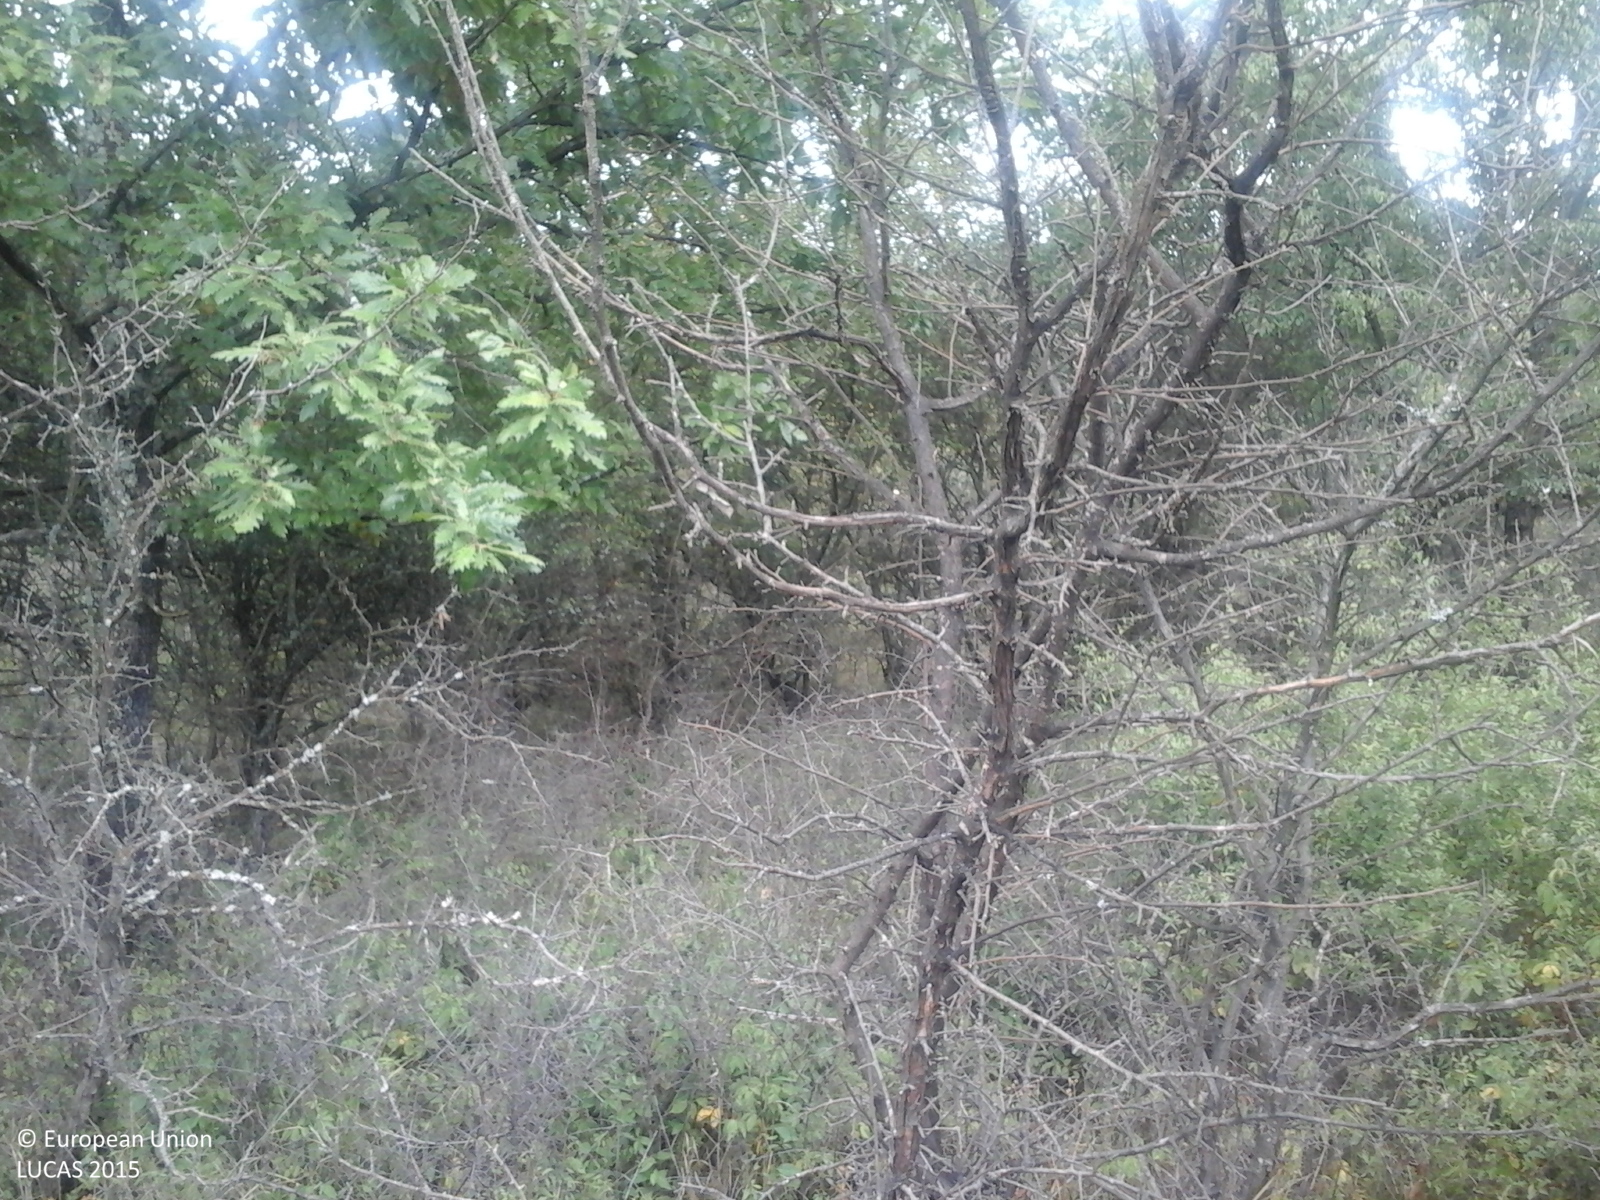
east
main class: Shrubland
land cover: Shrubland with sparse tree cover
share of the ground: 25 - 50 %
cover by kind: herbaceous plants 60 %, shrubs 35 %, broadleaved forest trees 5 %
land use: Abandoned areas
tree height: < 5 m
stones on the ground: < 10 %
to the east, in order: Shrubland with sparse tree cover; Broadleaved woodland
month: August
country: RO
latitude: 45.8971
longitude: 21.6229
